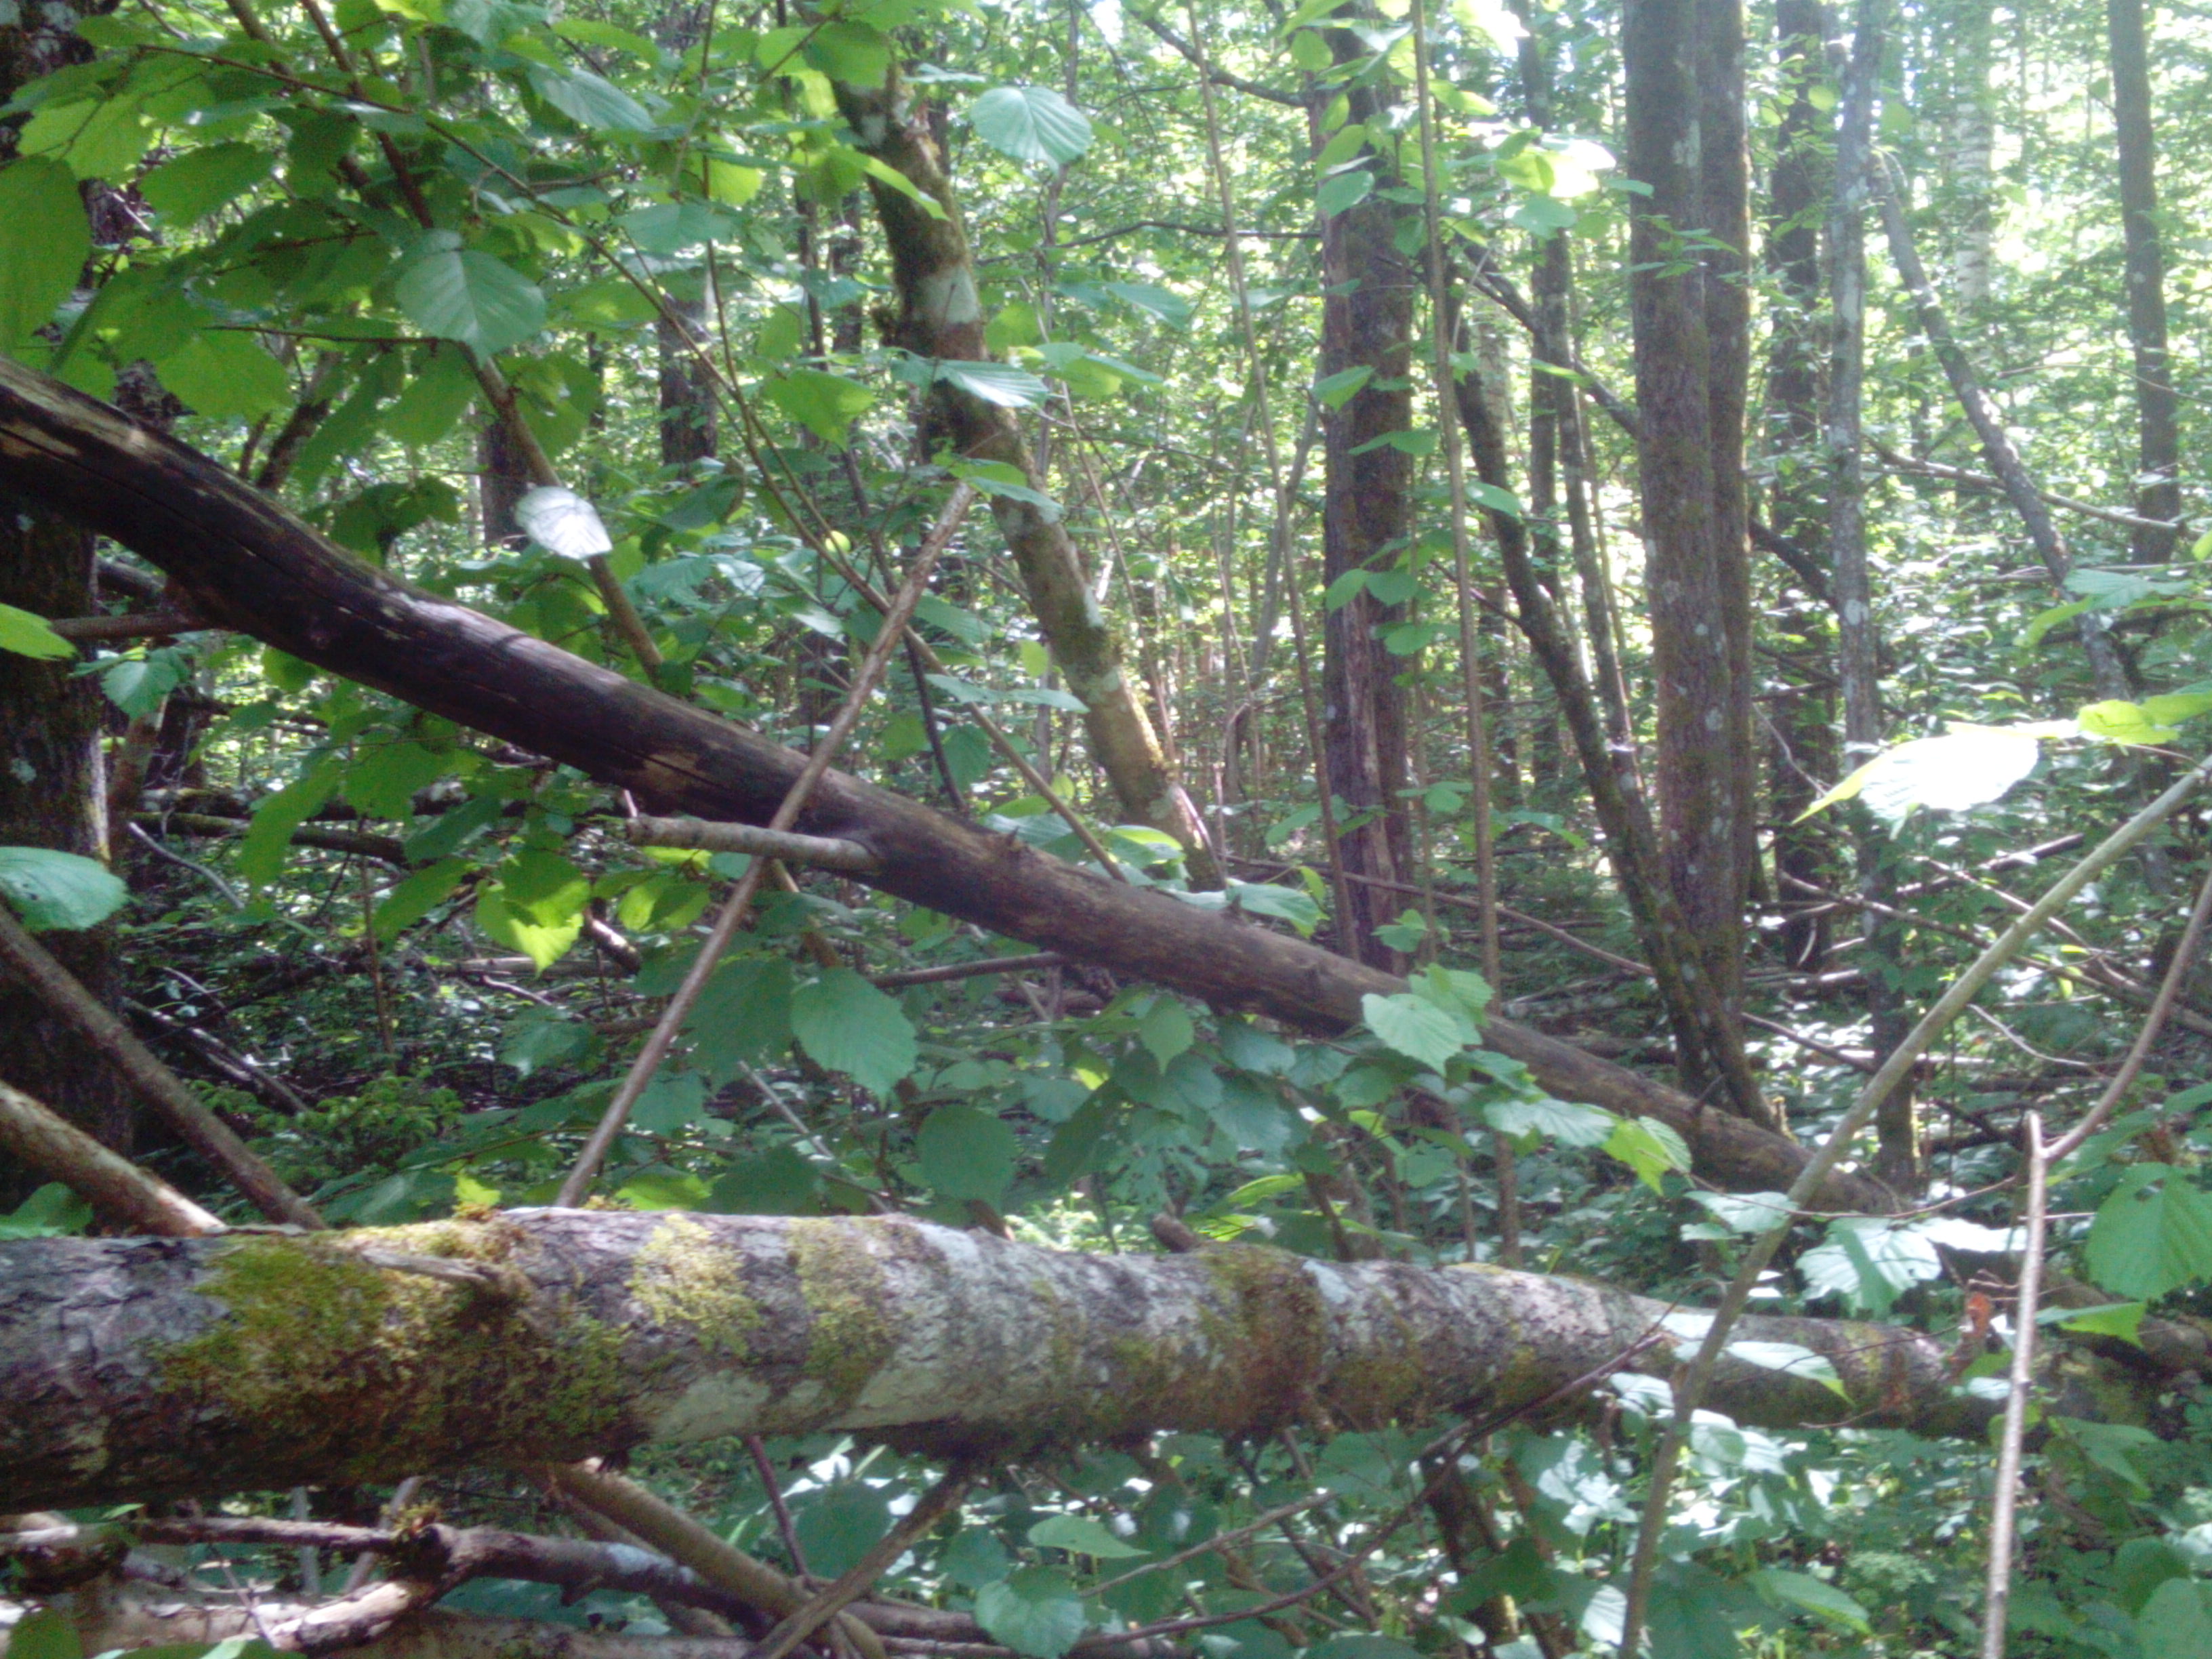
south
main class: Woodland
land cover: Broadleaved woodland
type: non-riverine alder, birch or aspen forest
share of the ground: > 75 %
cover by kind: broadleaved forest trees 90 %, shrubs 5 %, herbaceous plants 5 %
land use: Forestry
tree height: > 5 m
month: June
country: LV
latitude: 56.8126
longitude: 21.7233
